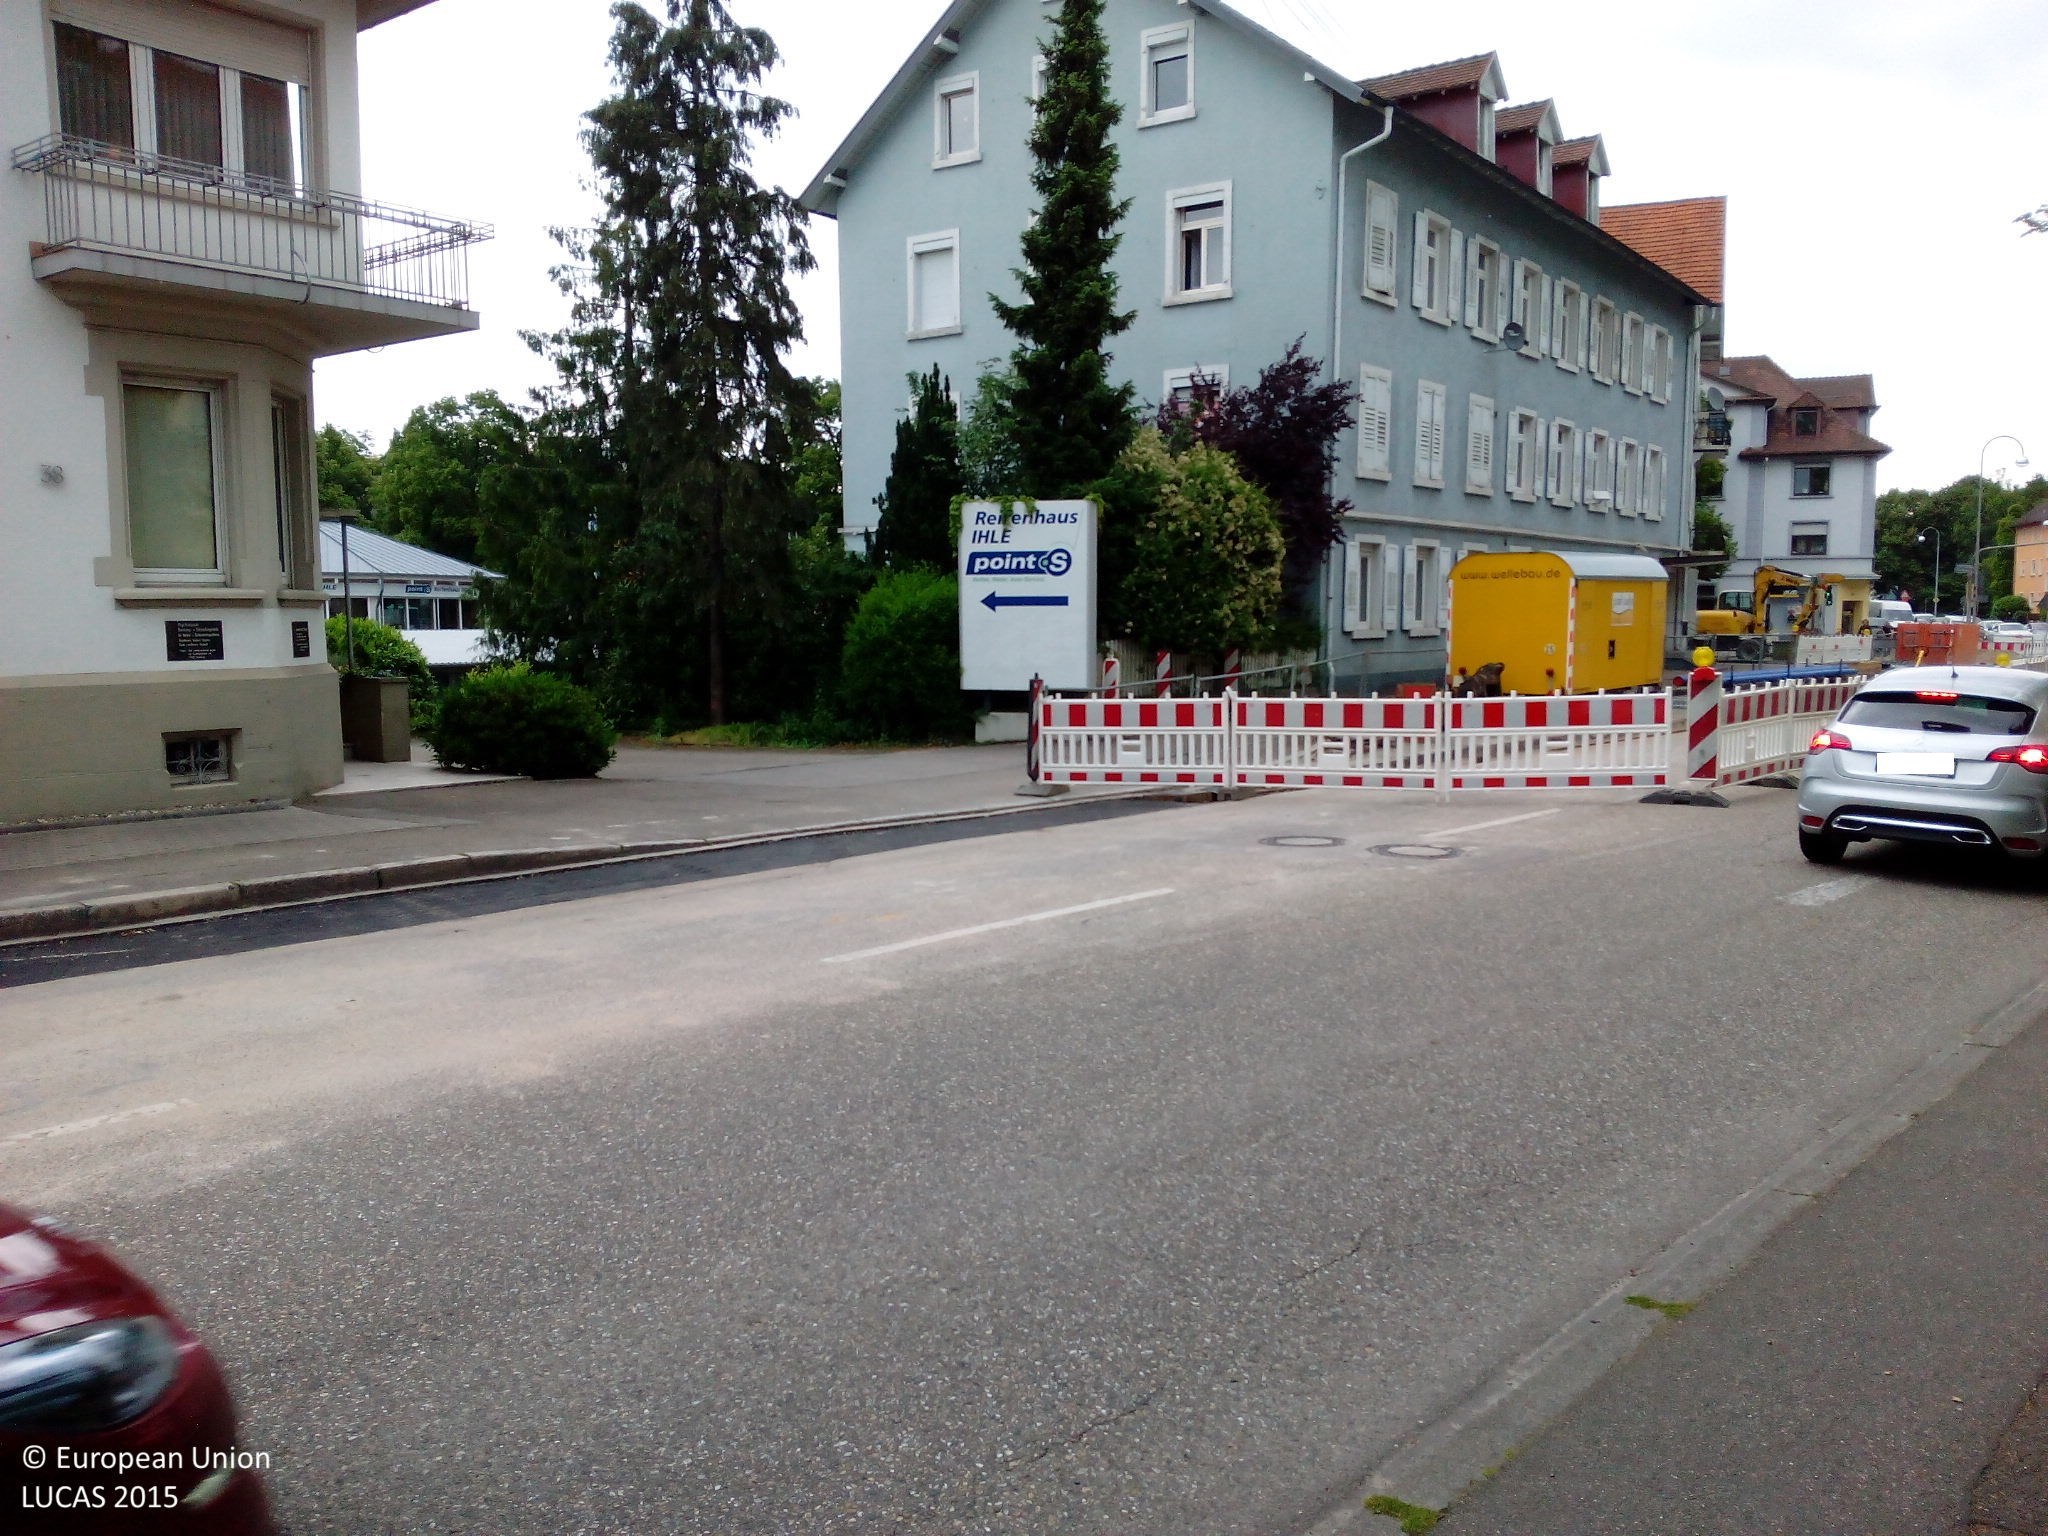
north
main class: Grassland
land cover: Grassland without tree/shrub cover
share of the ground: > 75 %
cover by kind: herbaceous plants 90 %, unconsolidated bare surface 10 %
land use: Residential
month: May
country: DE
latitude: 48.7846
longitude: 8.1905
